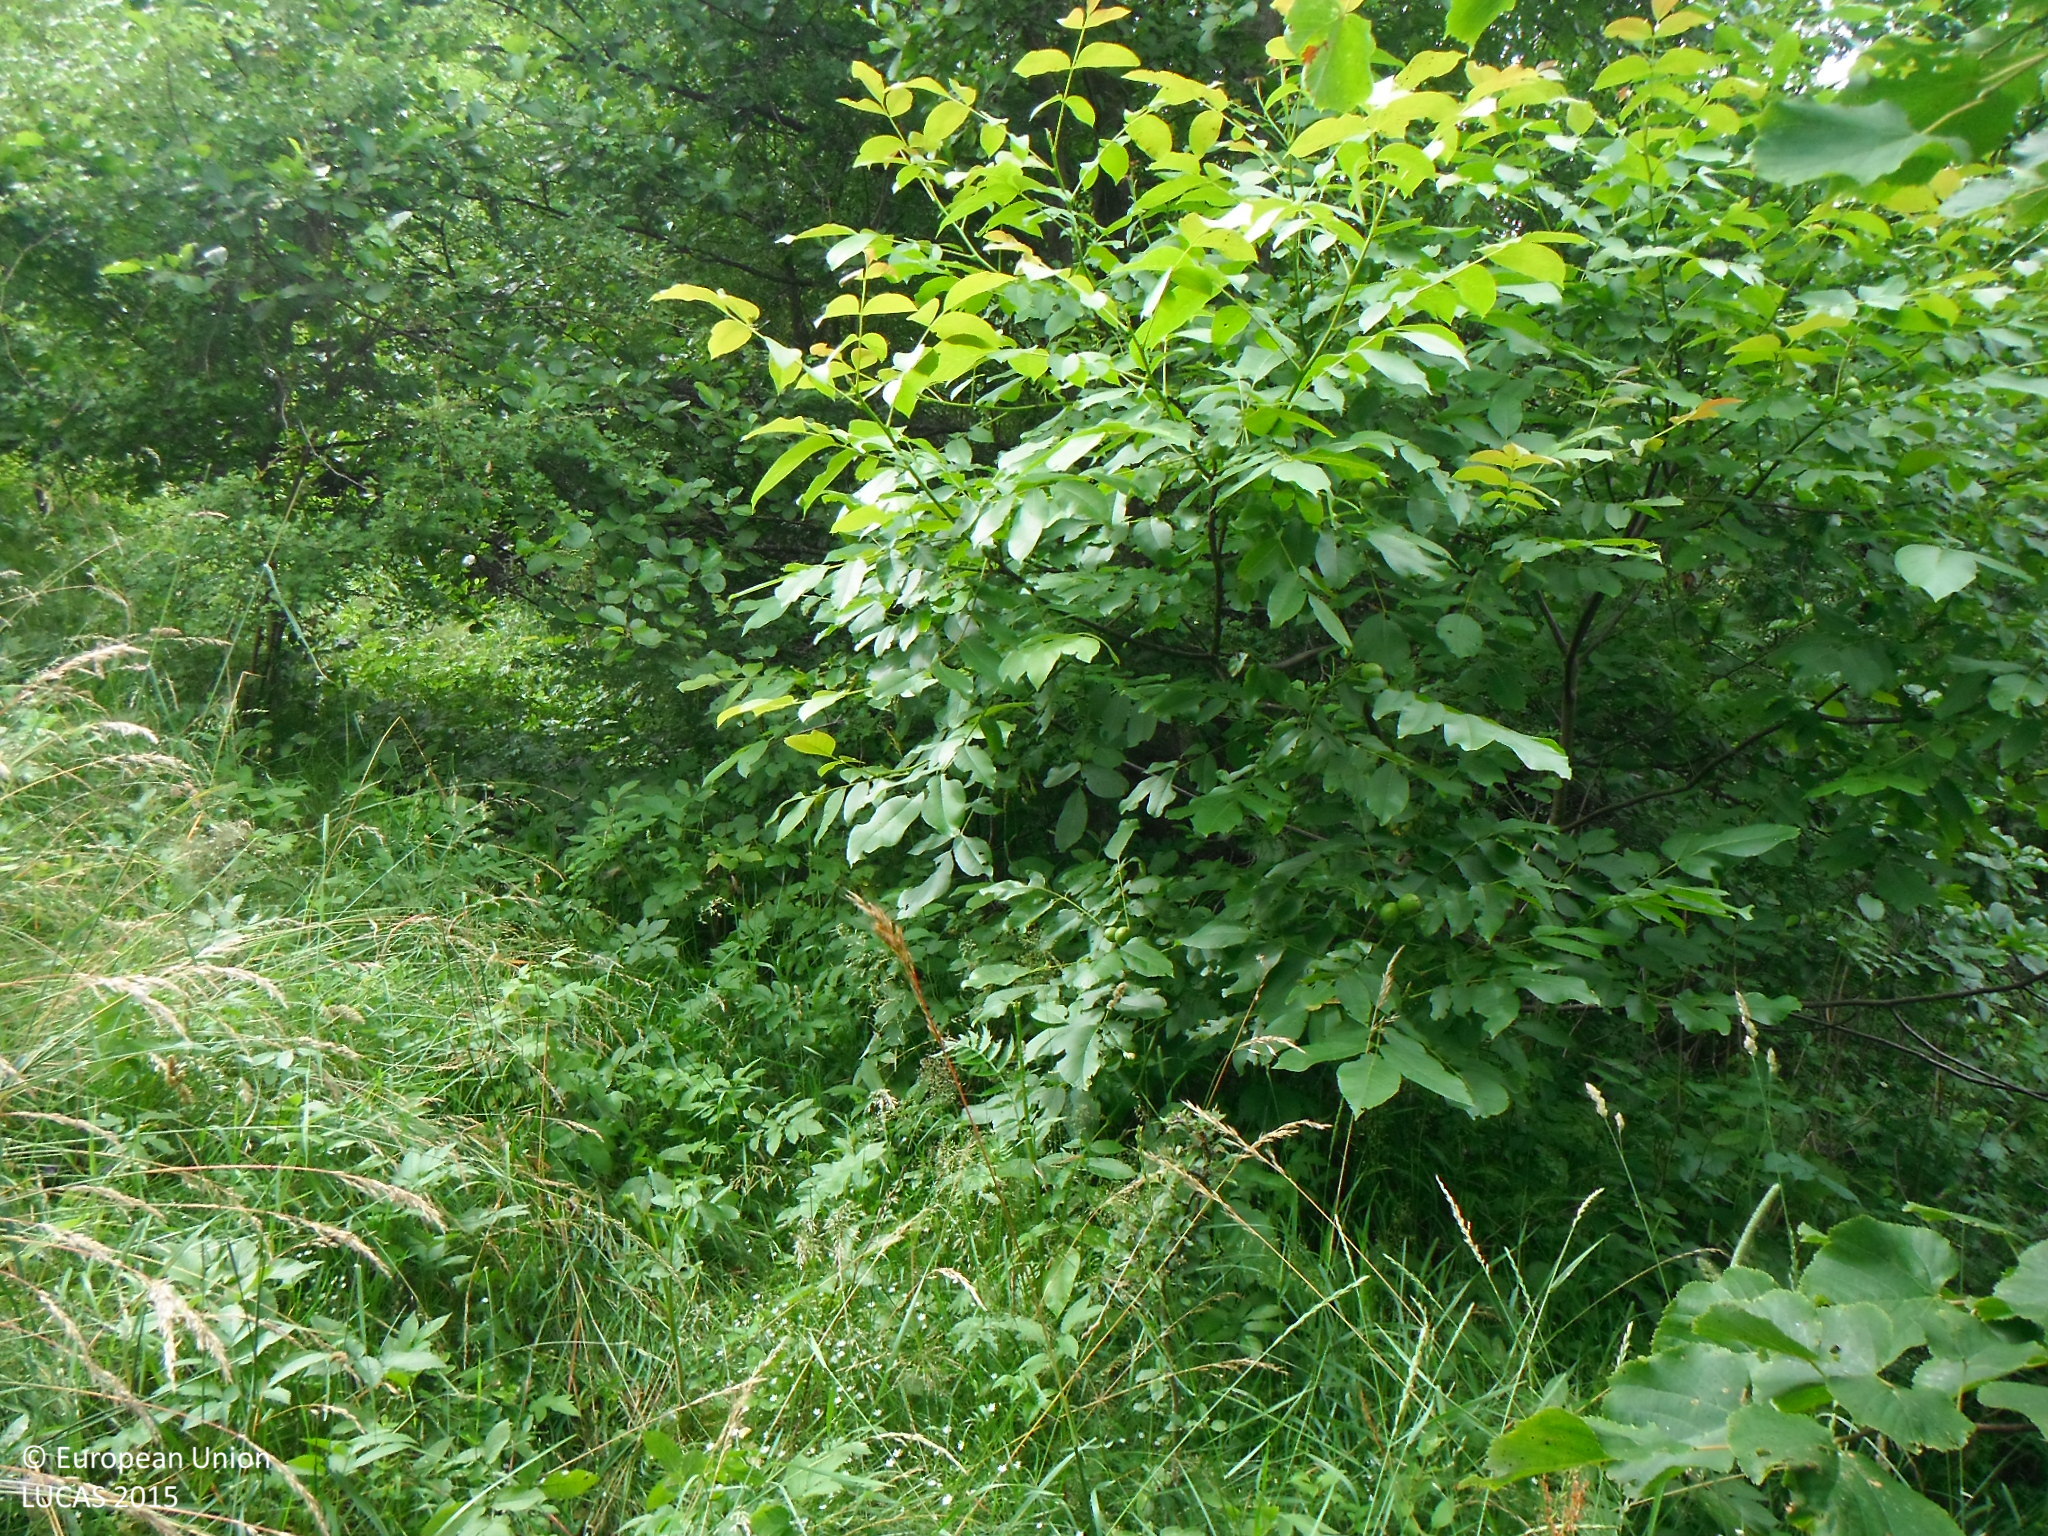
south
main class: Woodland
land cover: Broadleaved woodland
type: mesophytic deciduous forest
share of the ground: 25 - 50 %
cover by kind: broadleaved forest trees 60 %, herbaceous plants 30 %, shrubs 10 %
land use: Forestry
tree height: > 5 m
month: June
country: SK
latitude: 48.6780
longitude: 19.9576
